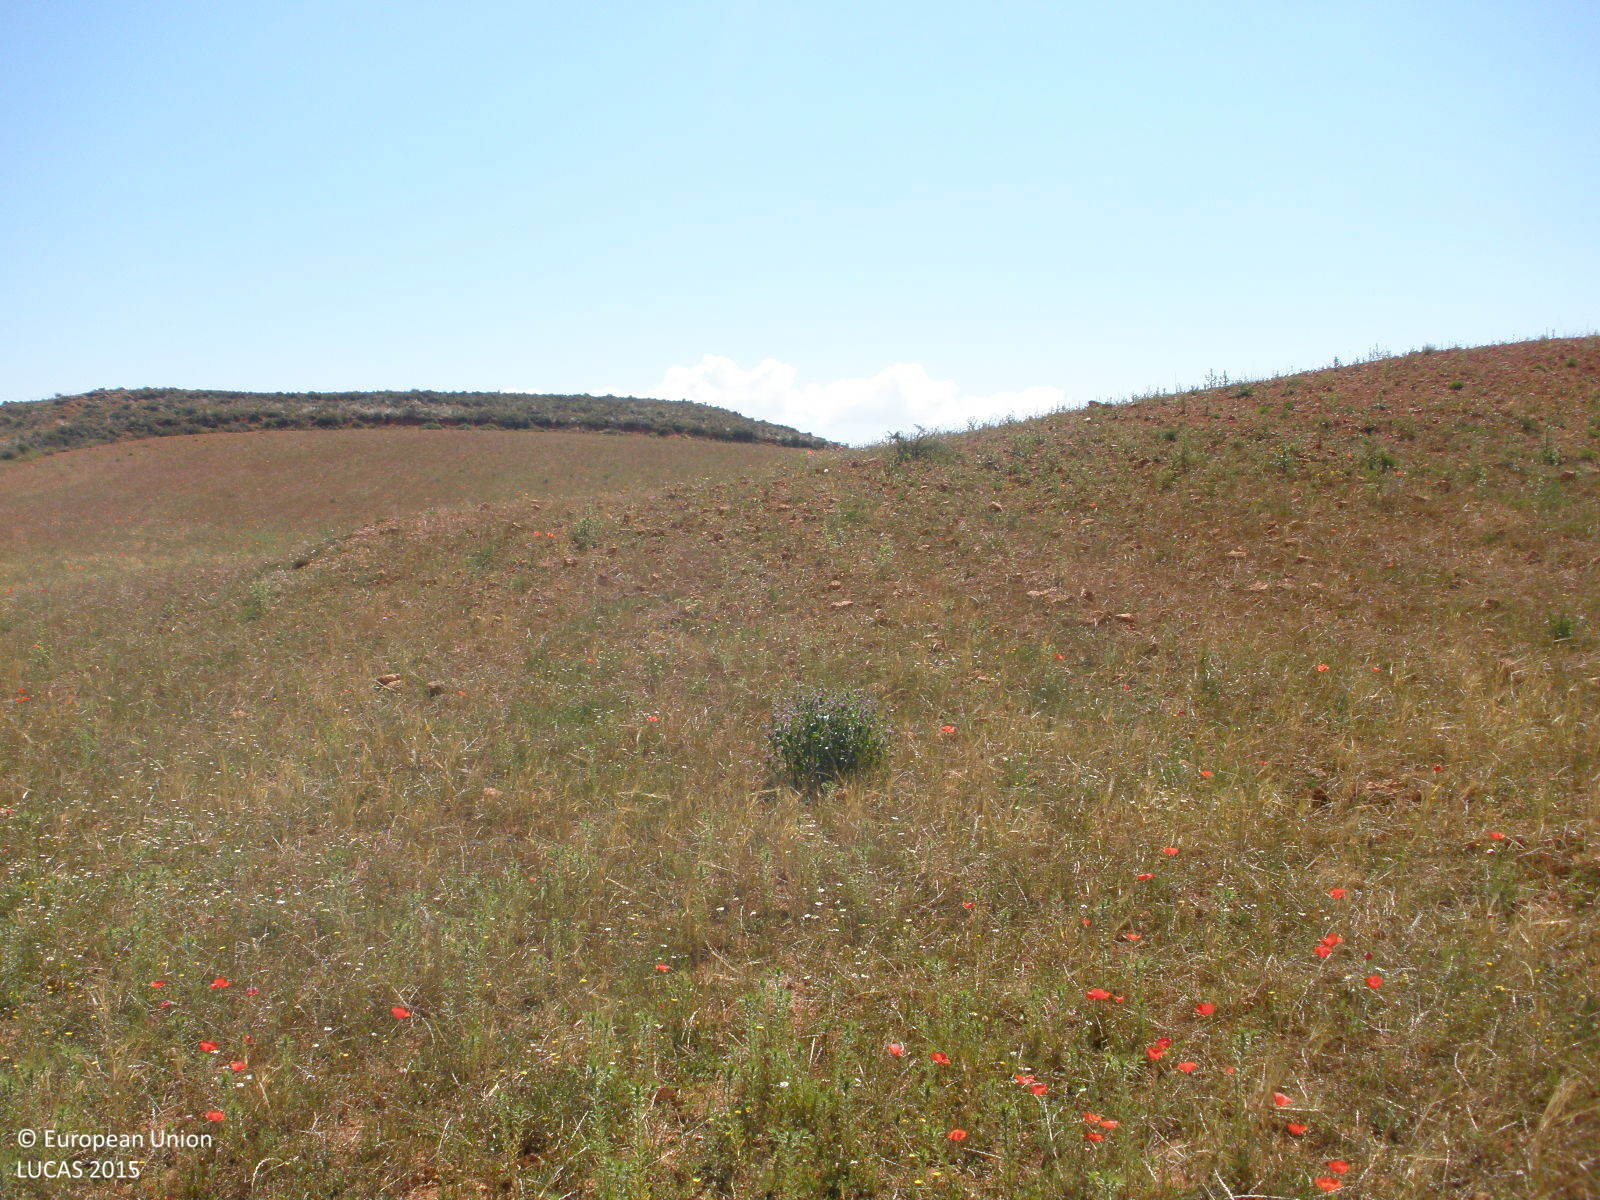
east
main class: Grassland
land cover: Spontaneously vegetated surfaces
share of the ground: > 75 %
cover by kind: herbaceous plants 90 %, unconsolidated bare surface 10 %
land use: Fallow land
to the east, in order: Spontaneously vegetated surfaces; Shrubland without tree cover; Common wheat; Shrubland without tree cover
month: June
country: ES
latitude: 40.5323
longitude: -1.0740
